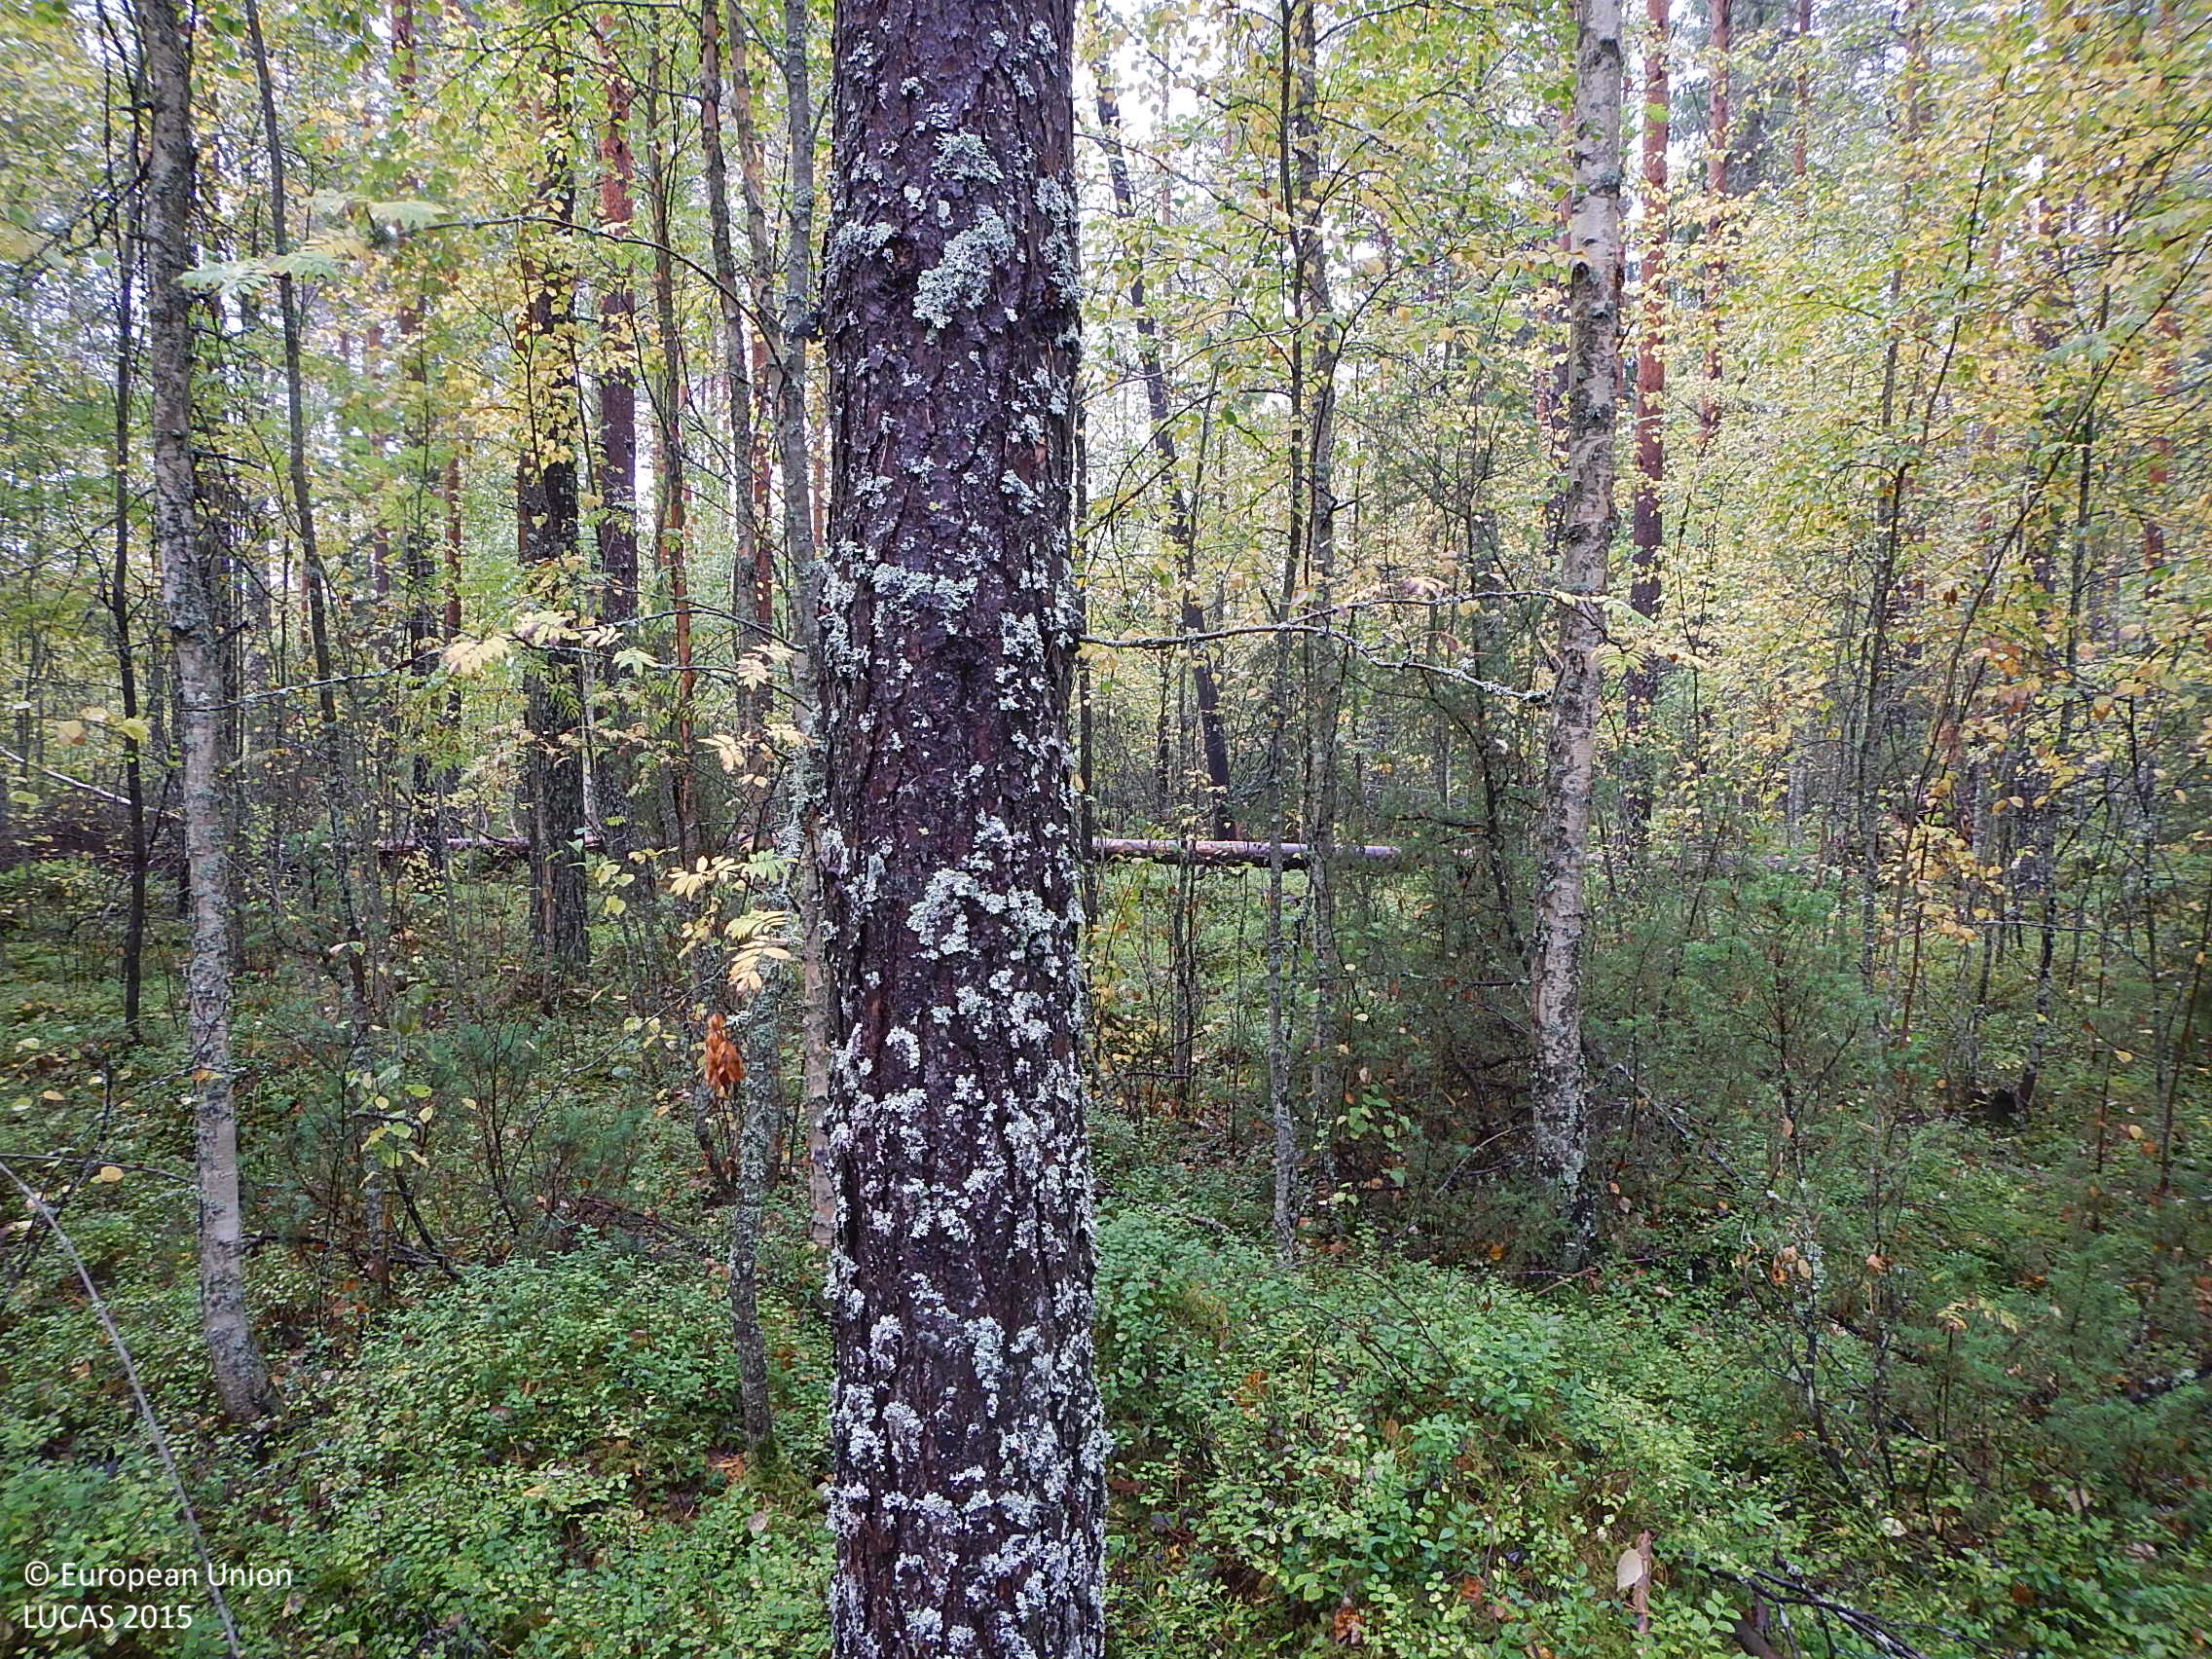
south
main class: Woodland
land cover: Pine dominated mixed woodland
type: boreal forest
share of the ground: > 75 %
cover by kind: coniferous forest trees 45 %, broadleaved forest trees 30 %, shrubs 20 %, lichens and mosses 5 %
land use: Forestry
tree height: > 5 m
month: September
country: FI
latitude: 61.8405
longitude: 22.1942
